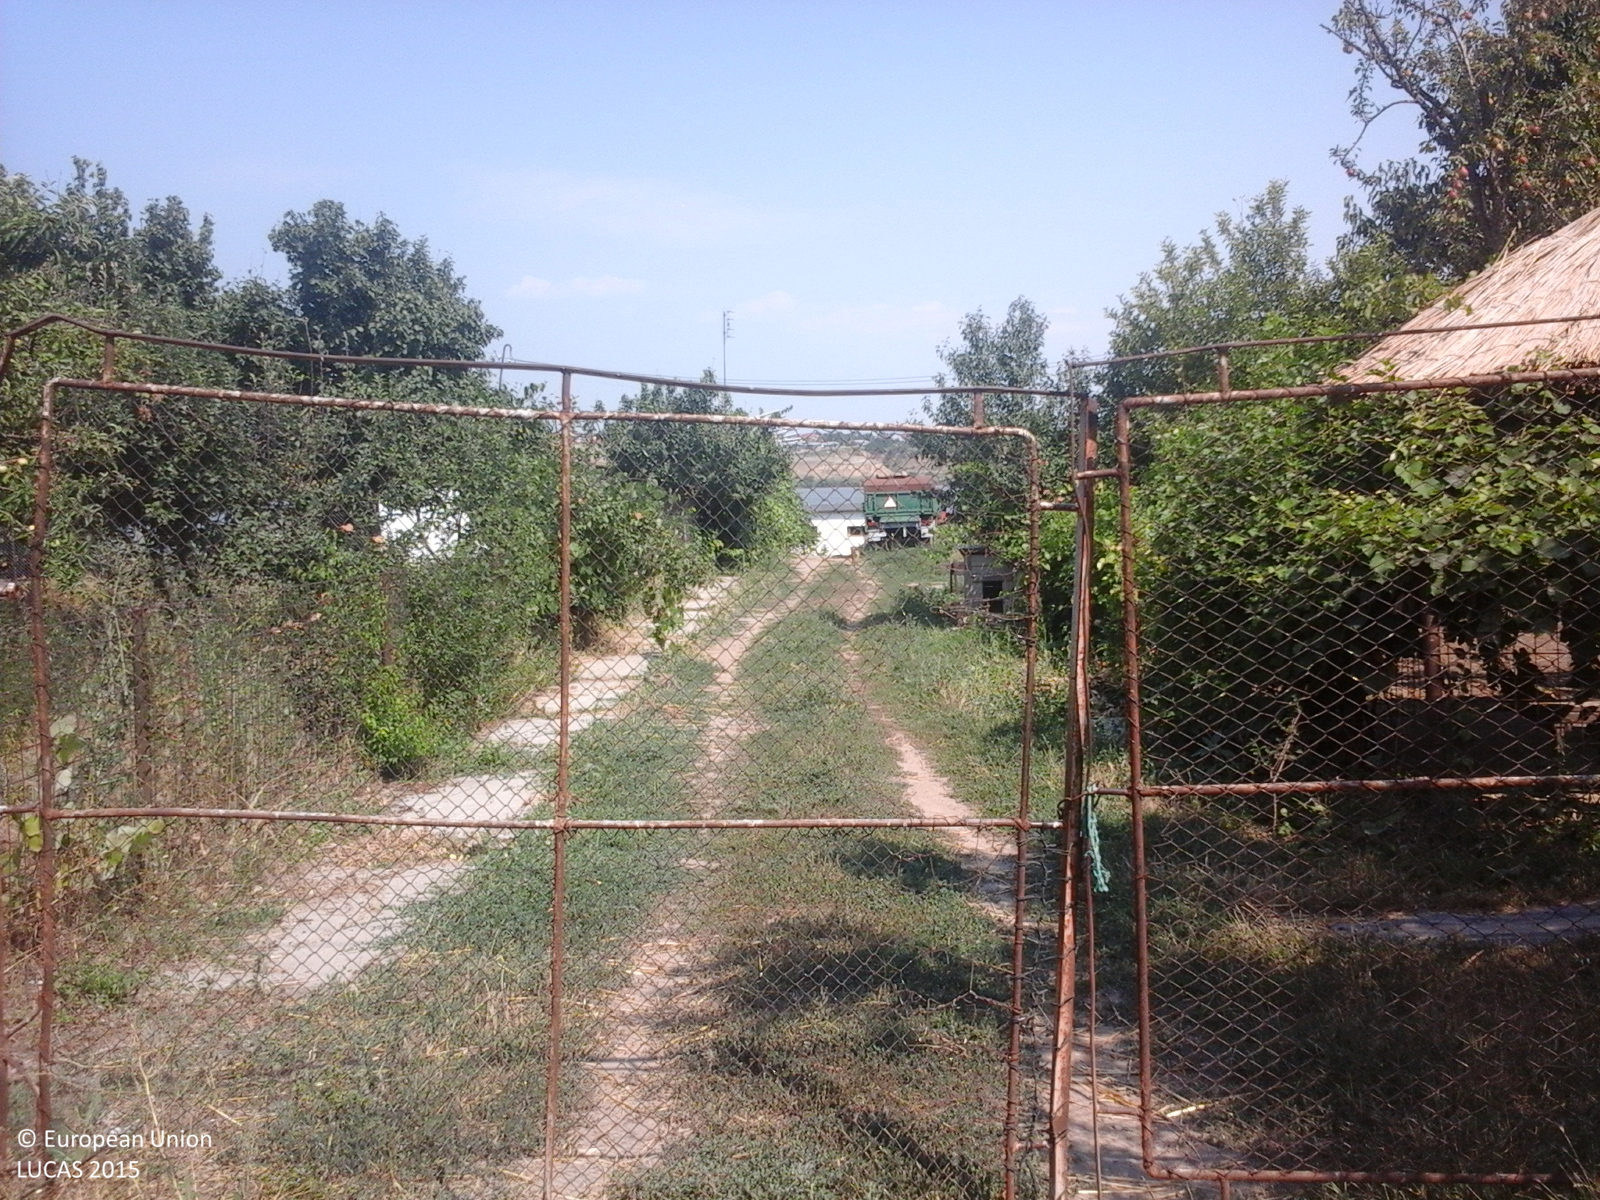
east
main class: Cropland
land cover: Apple fruit
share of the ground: > 75 %
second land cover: Grassland without tree/shrub cover
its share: > 75 %
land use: Kitchen garden
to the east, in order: Apple fruit; Grassland without tree/shrub cover; Artificial constructions in urban areas; Shrubland with sparse tree cover; Inland fresh water bodies
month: July
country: RO
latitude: 45.4473
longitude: 27.8198
